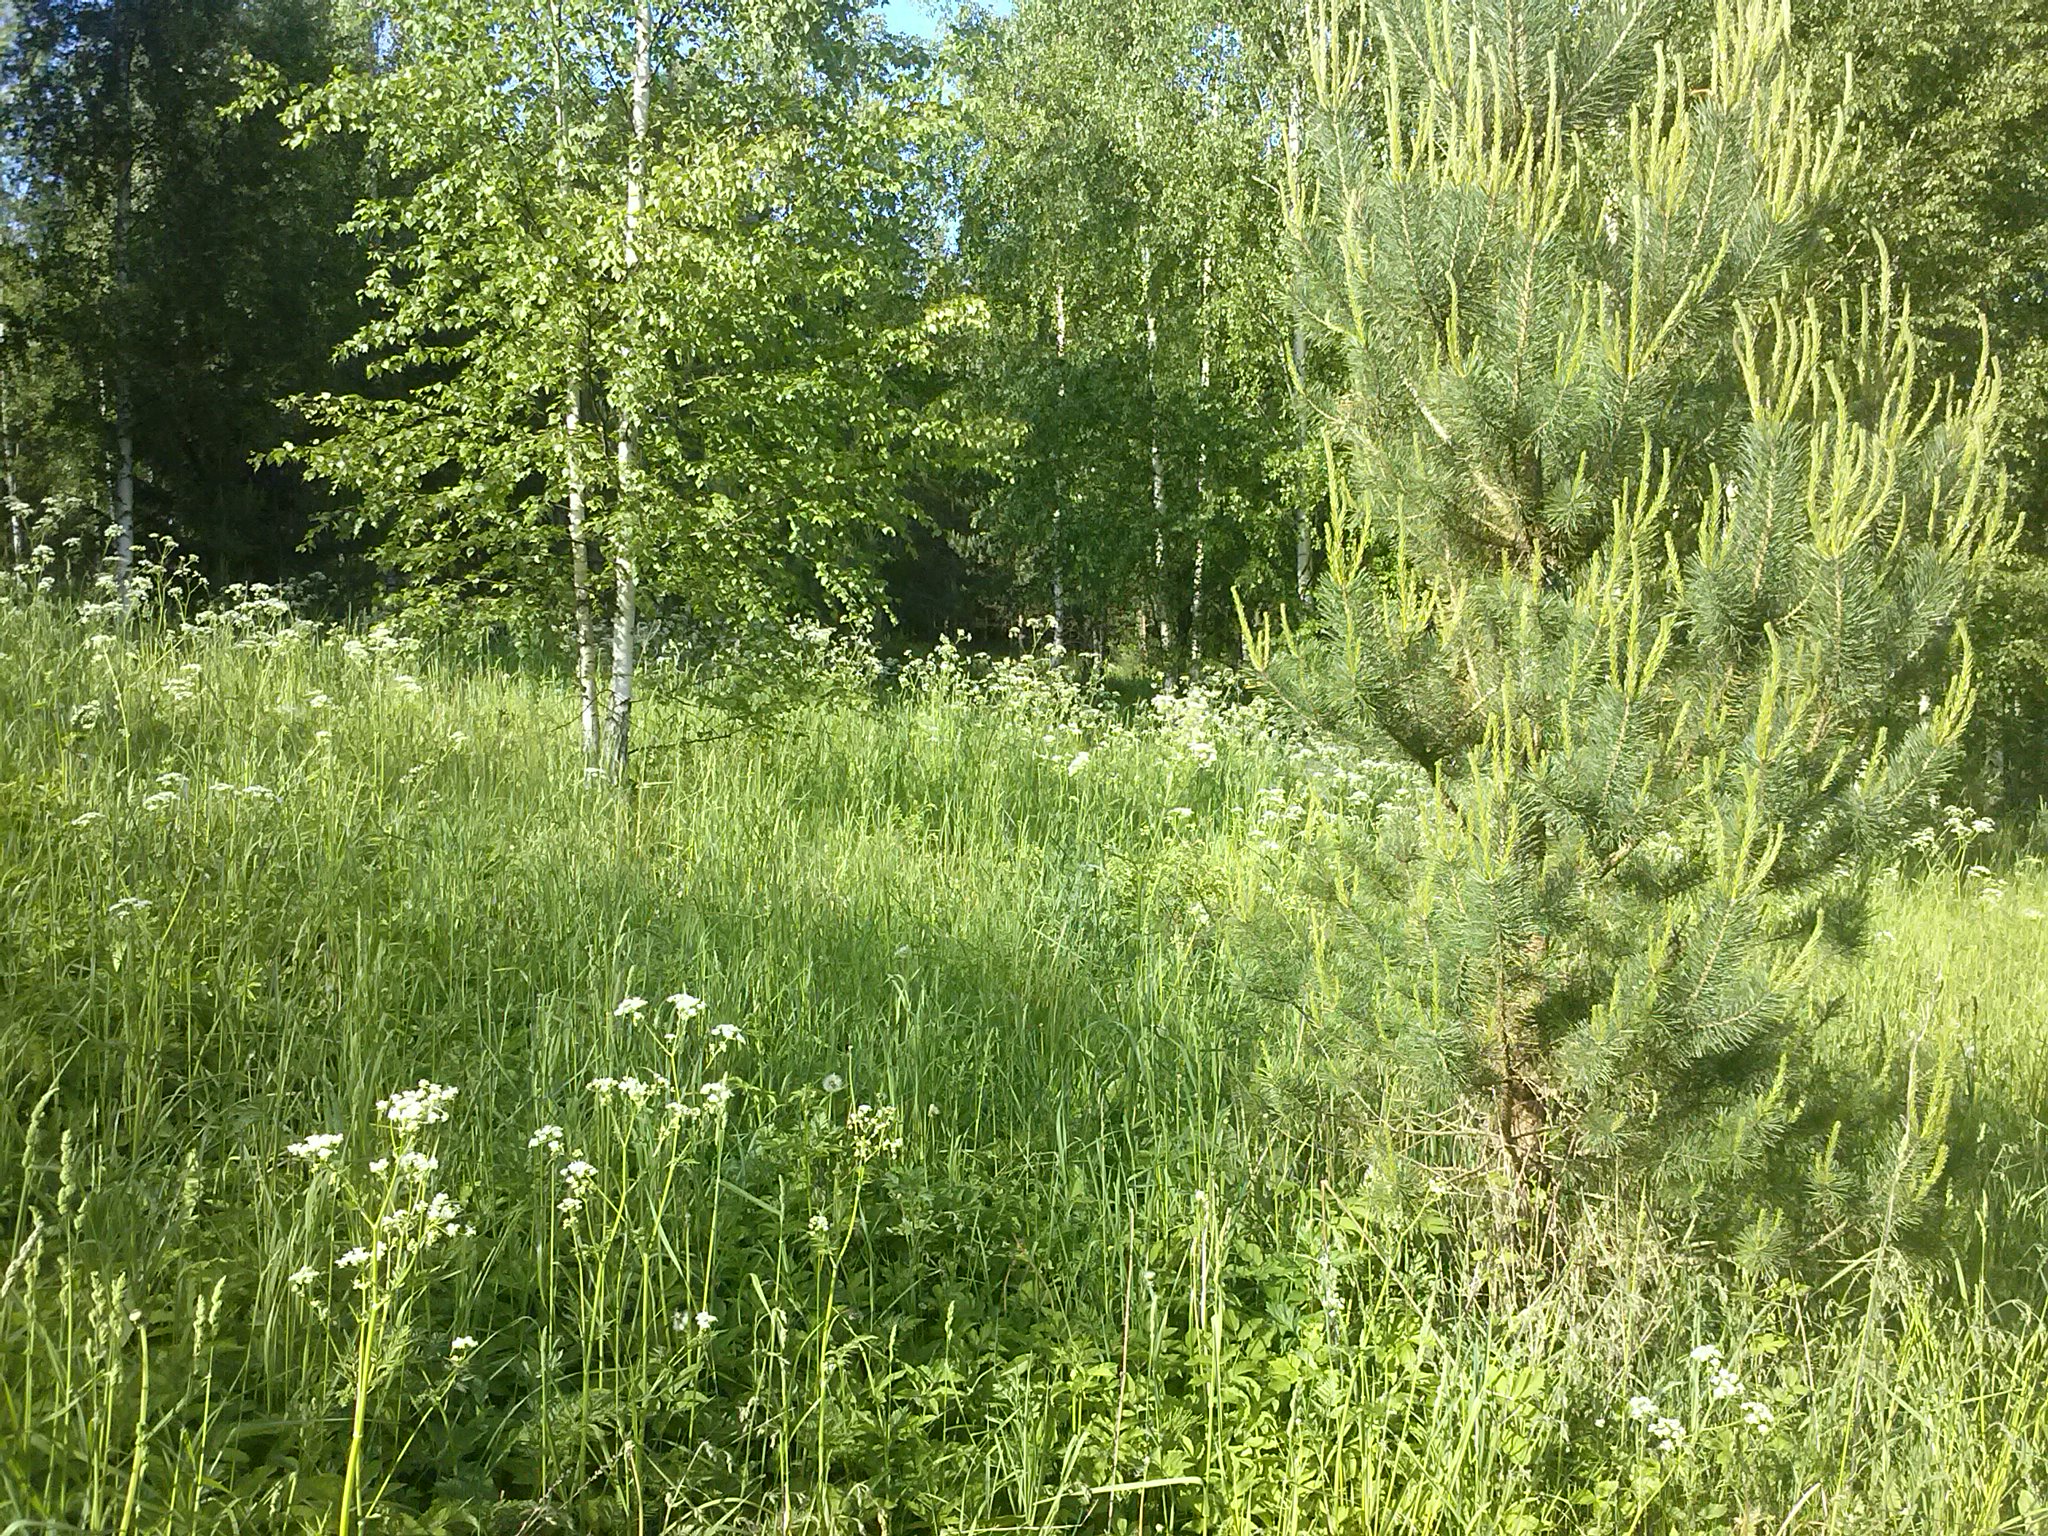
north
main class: Grassland
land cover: Grassland with sparse tree/shrub cover
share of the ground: > 75 %
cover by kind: herbaceous plants 90 %, coniferous forest trees 5 %, shrubs 5 %
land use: Forestry
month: June
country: LV
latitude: 56.3530
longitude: 27.6461
